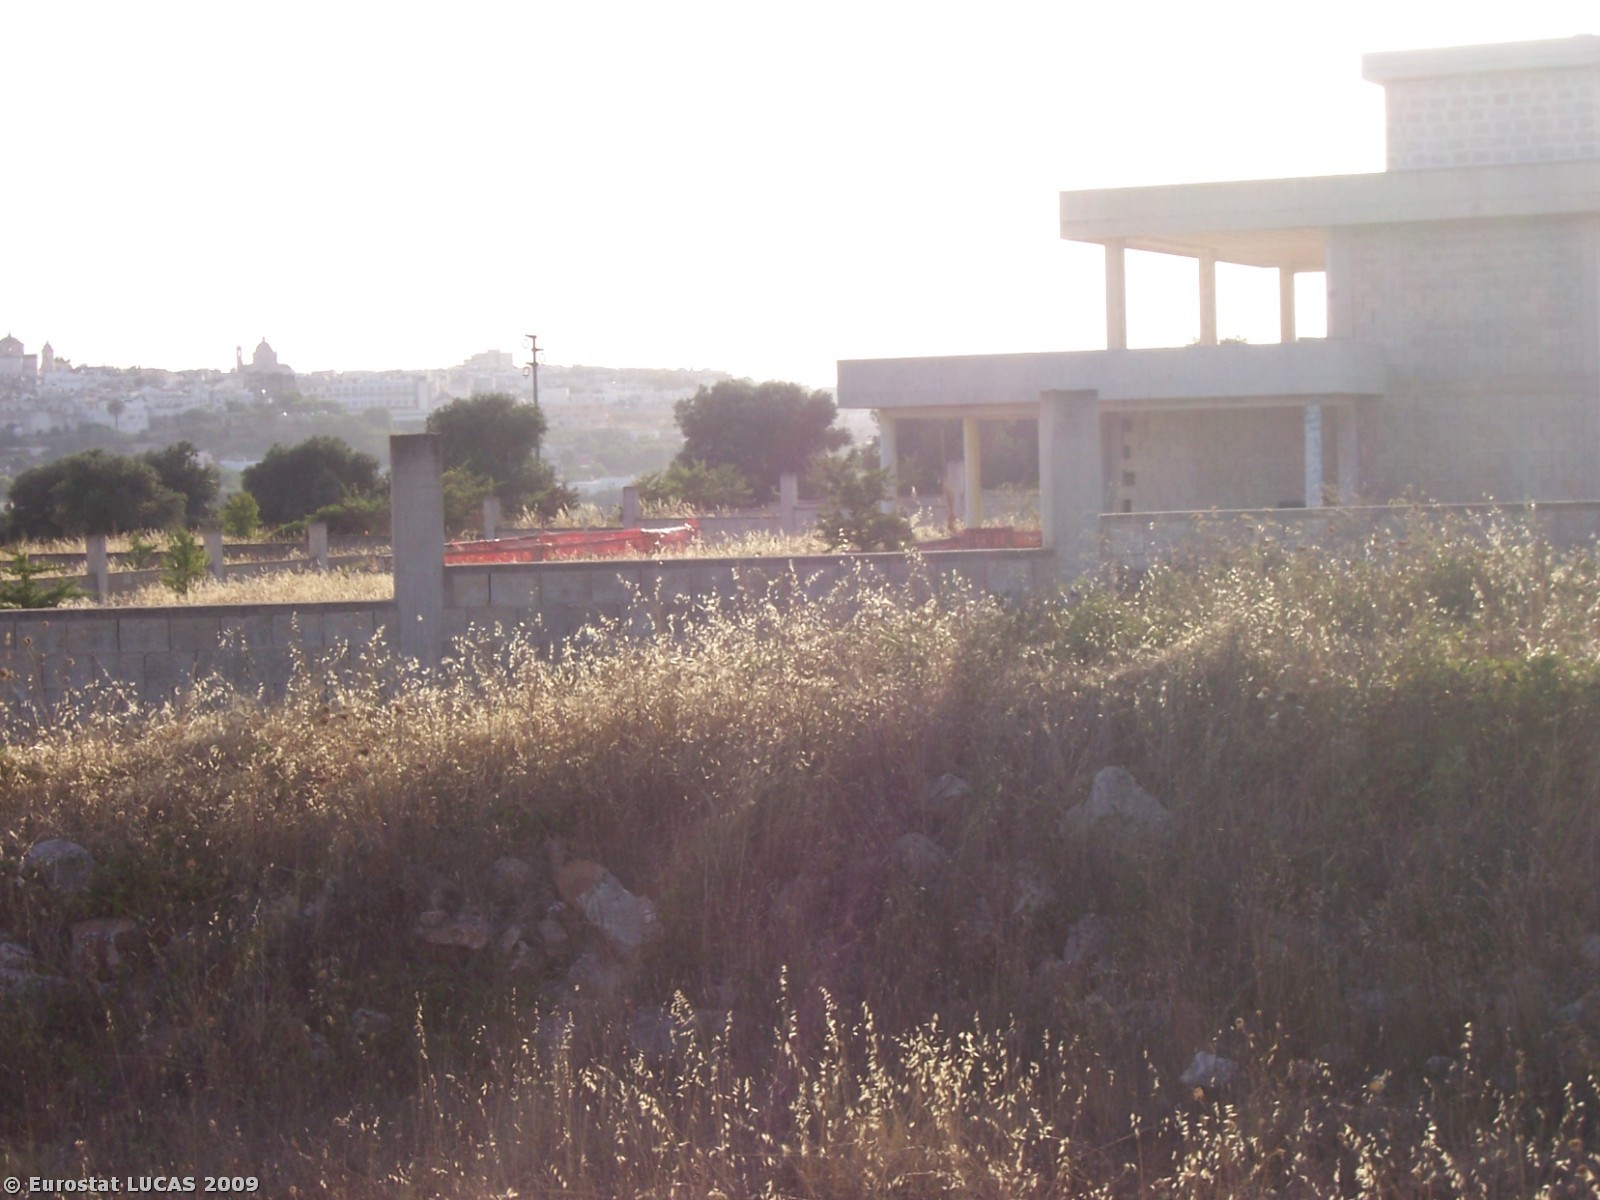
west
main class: Grassland
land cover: Spontaneously vegetated surfaces
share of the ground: > 75 %
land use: Fallow land
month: July
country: IT
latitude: 40.6494
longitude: 17.5336
